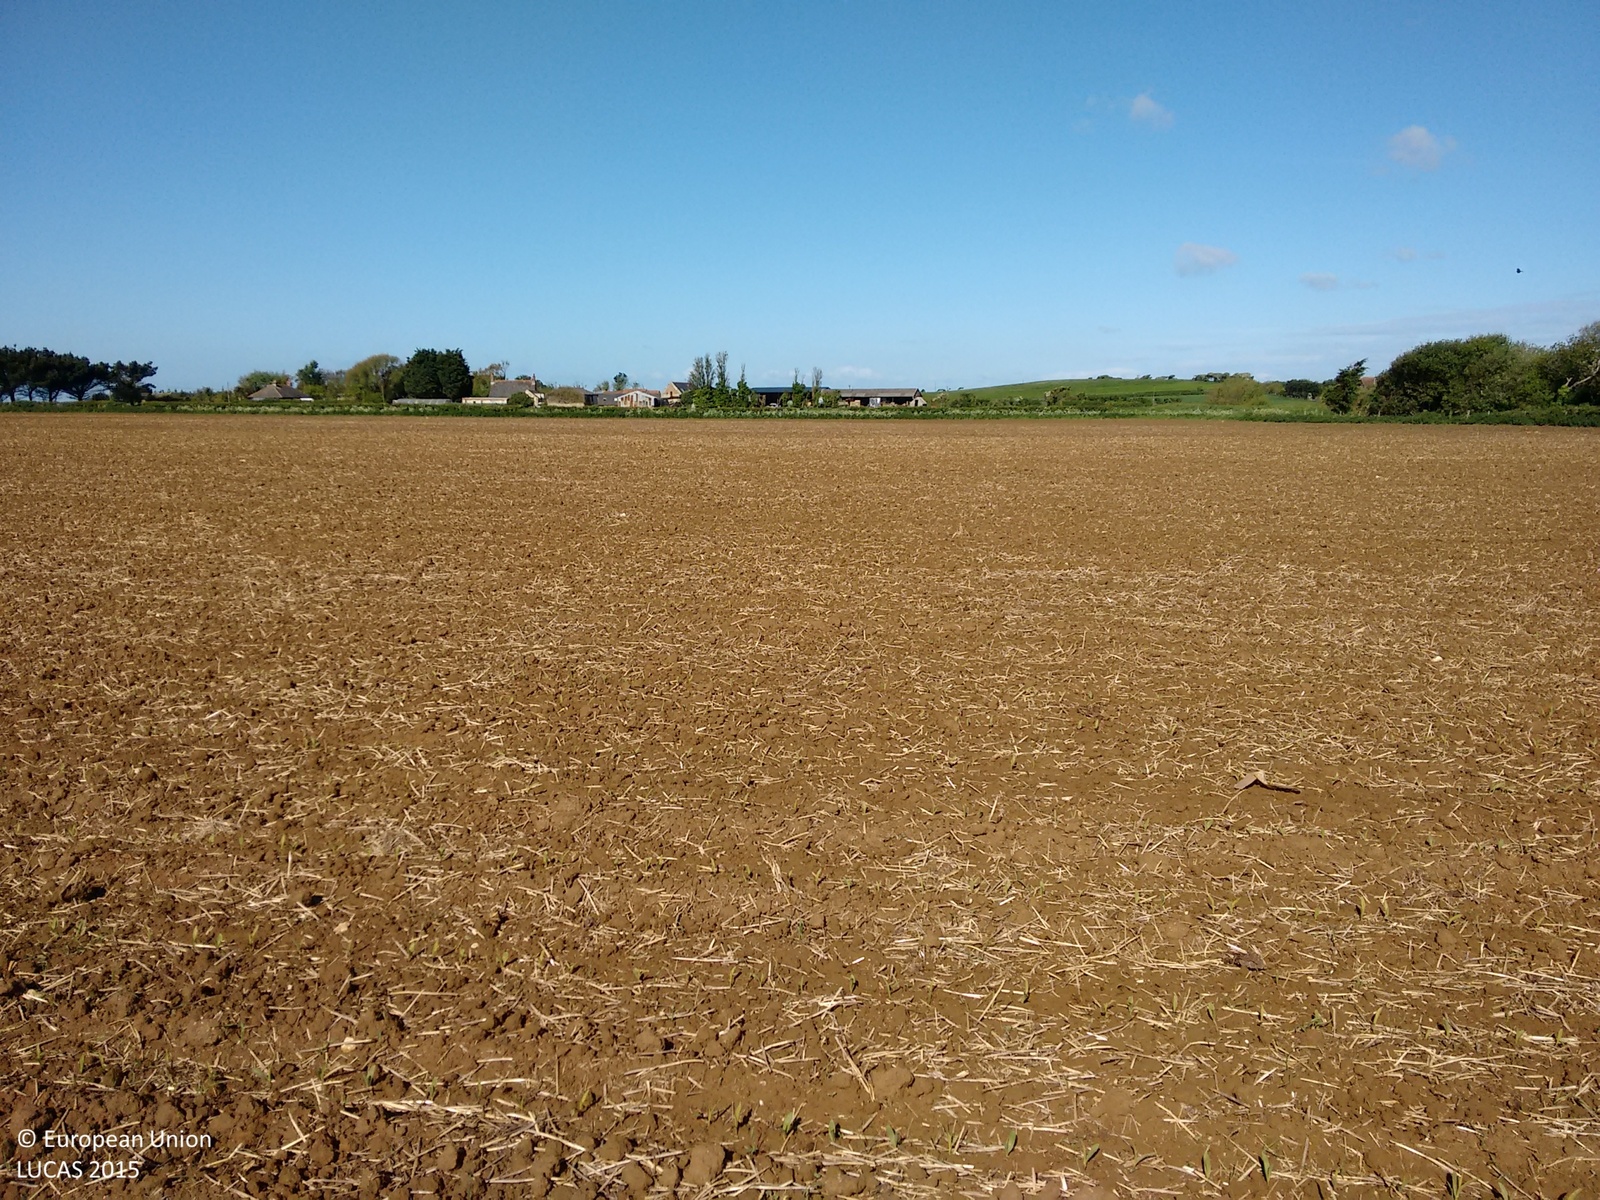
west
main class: Cropland
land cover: Maize
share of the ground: < 10 %
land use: Agriculture (excluding fallow land and kitchen gardens)
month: May
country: GB
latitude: 50.6152
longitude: -1.3407
